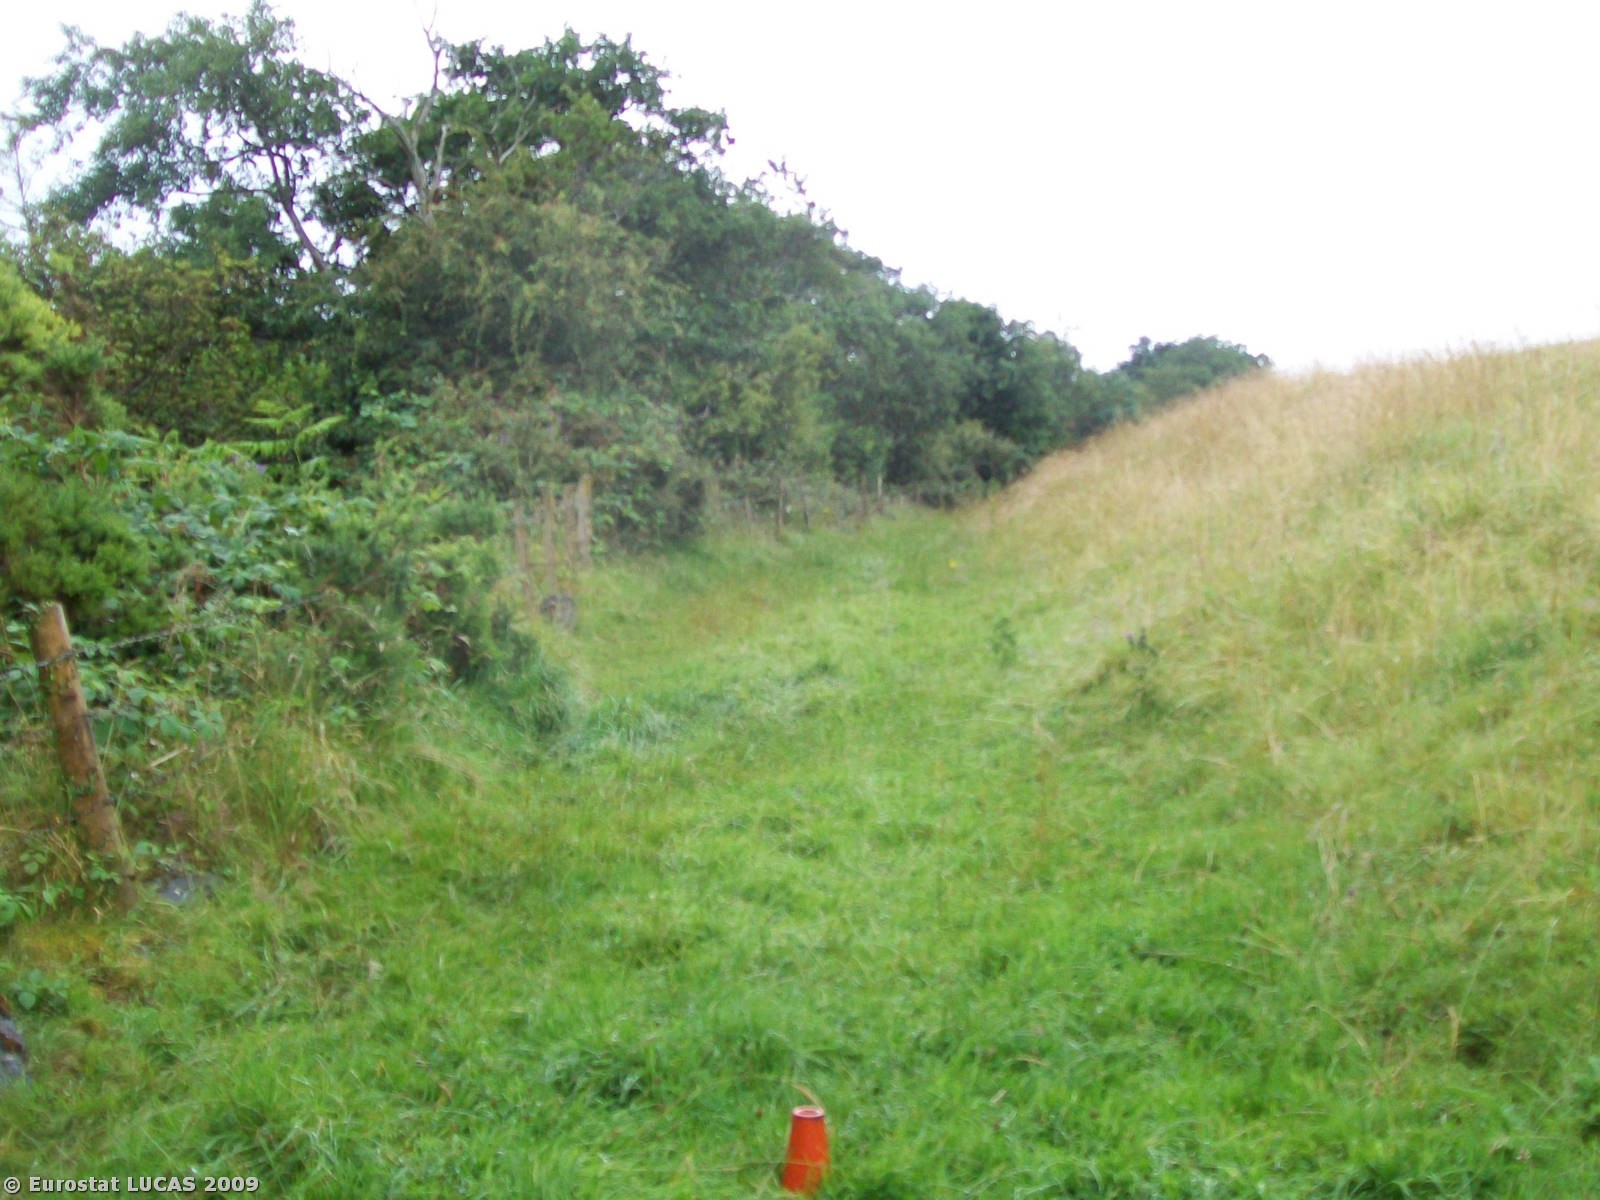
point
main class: Grassland
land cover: Grassland without tree/shrub cover
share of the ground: > 75 %
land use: Agriculture (excluding fallow land and kitchen gardens)
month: July
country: IE
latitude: 53.9361
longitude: -9.0880
